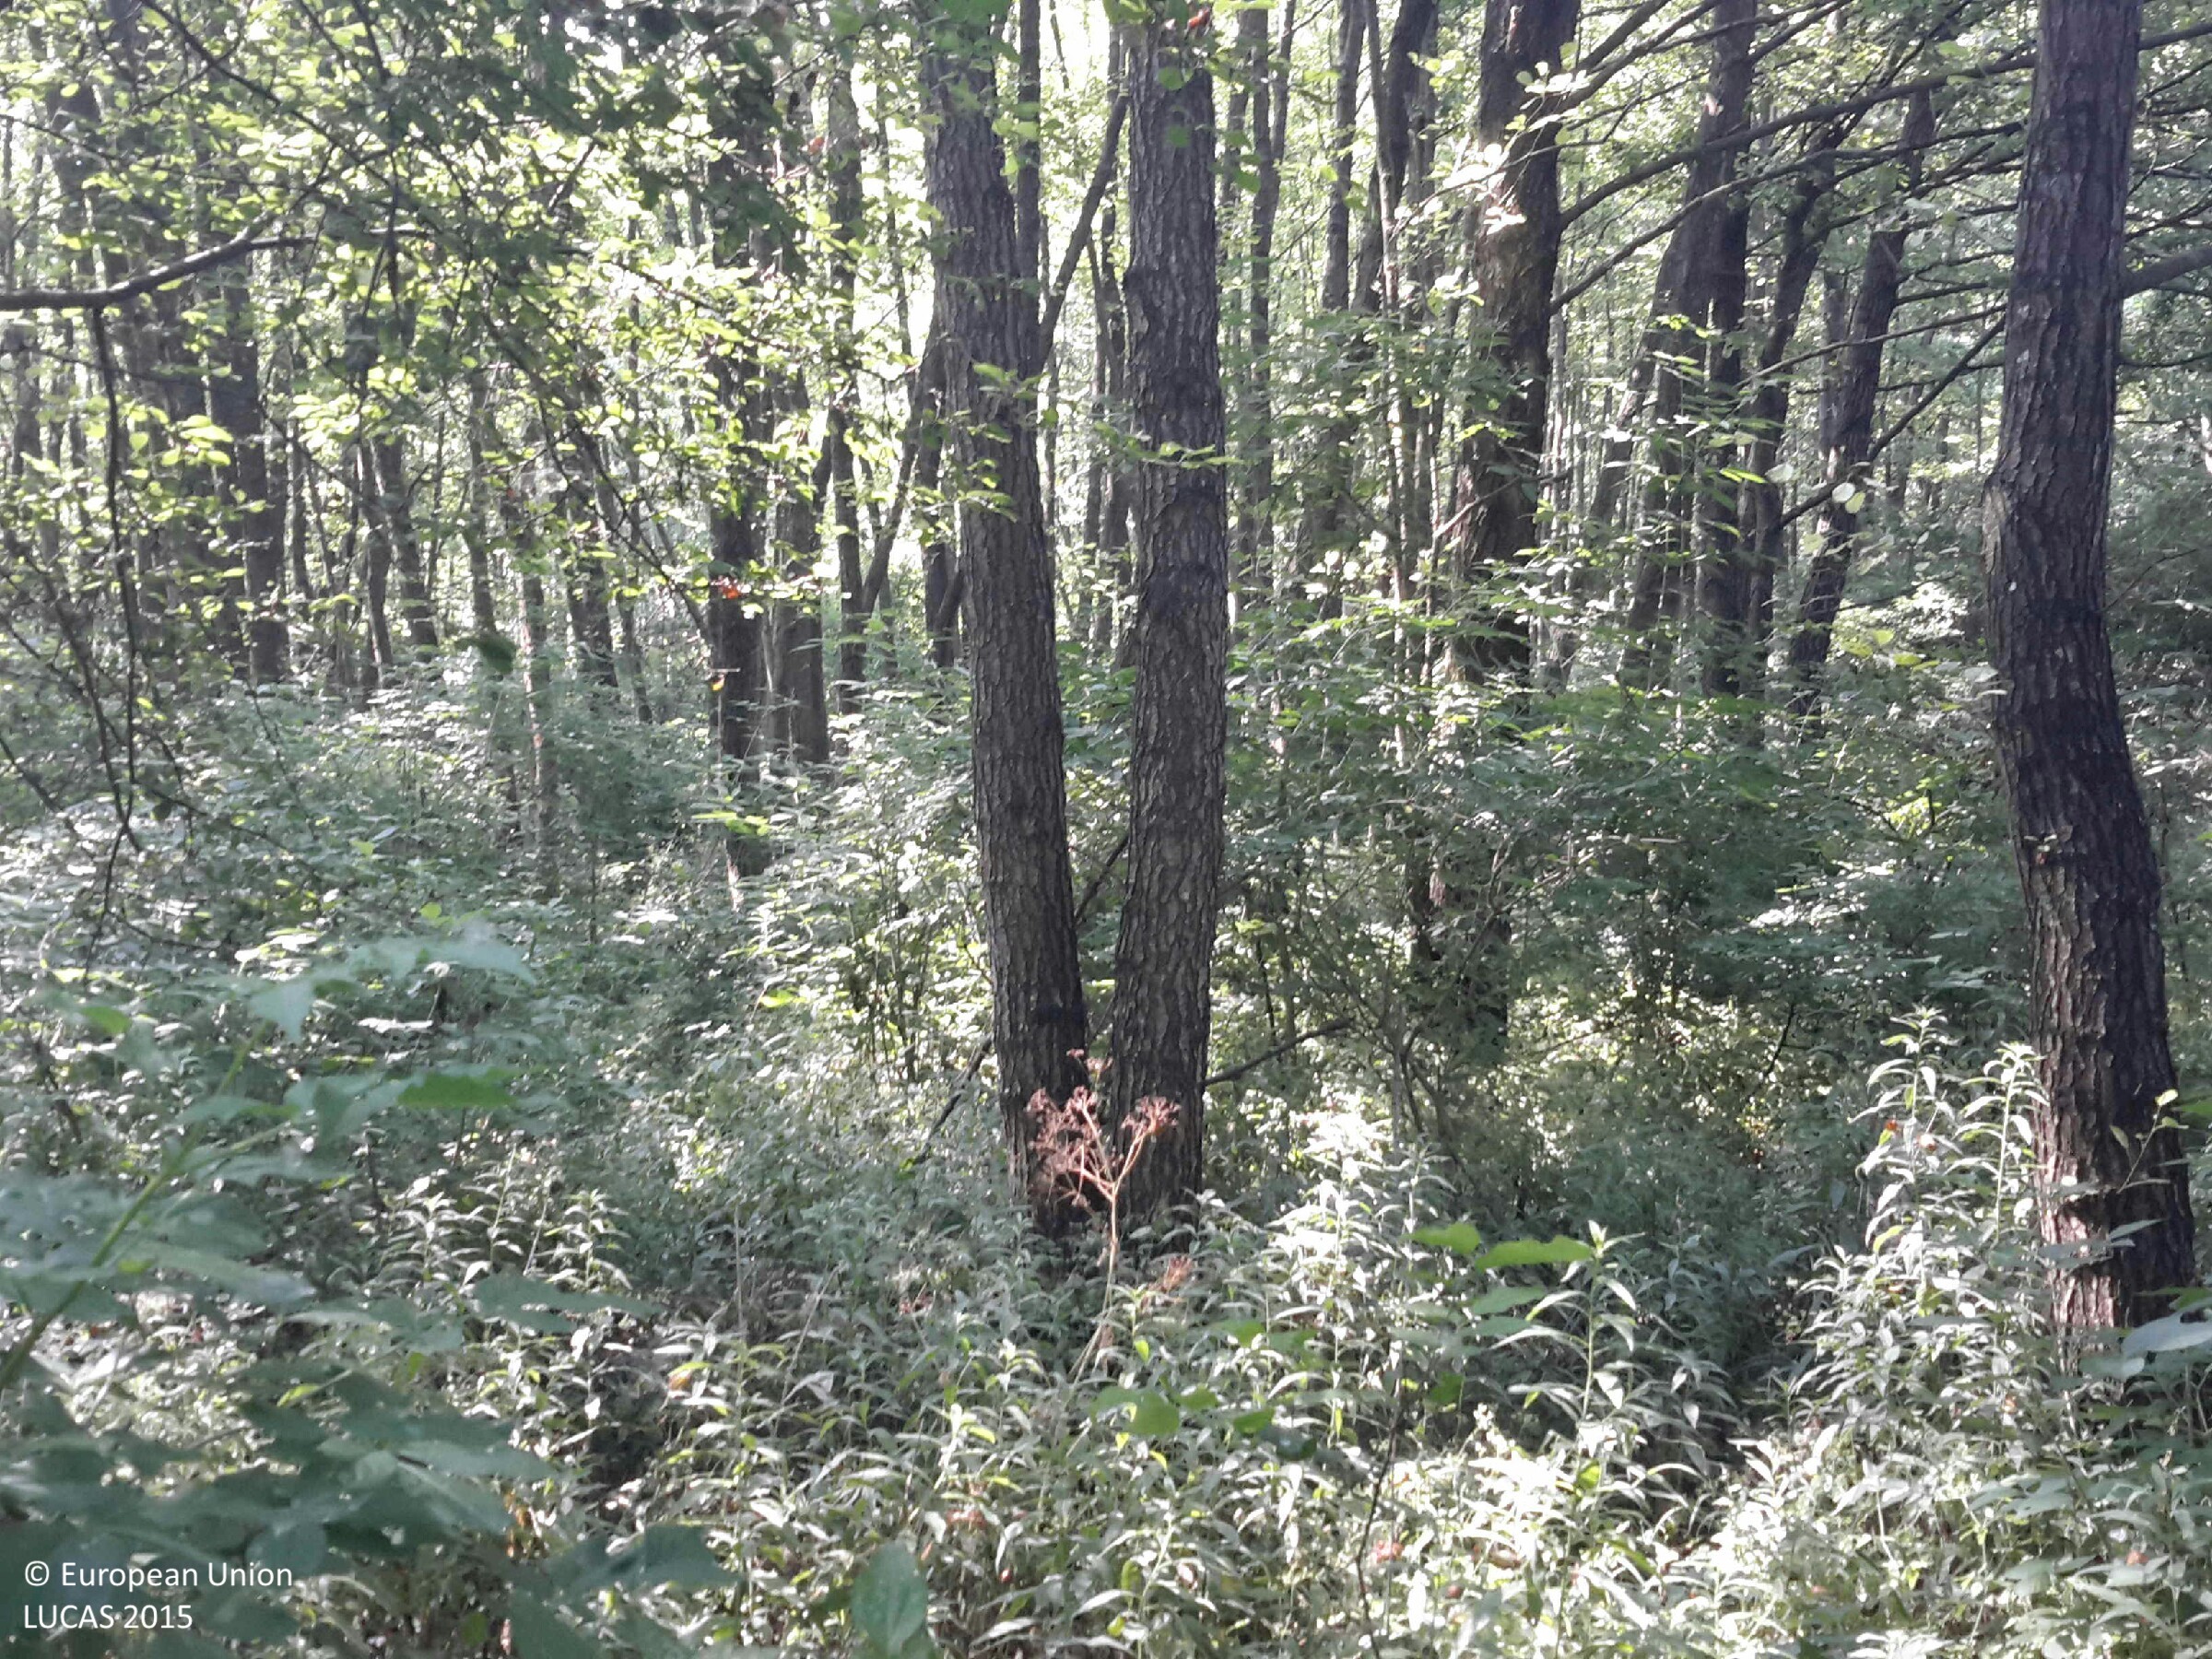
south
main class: Woodland
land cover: Broadleaved woodland
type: mesophytic deciduous forest
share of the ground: > 75 %
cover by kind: broadleaved forest trees 80 %, herbaceous plants 15 %, shrubs 5 %
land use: Forestry
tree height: > 5 m
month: July
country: HU
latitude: 47.2162
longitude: 17.1226
